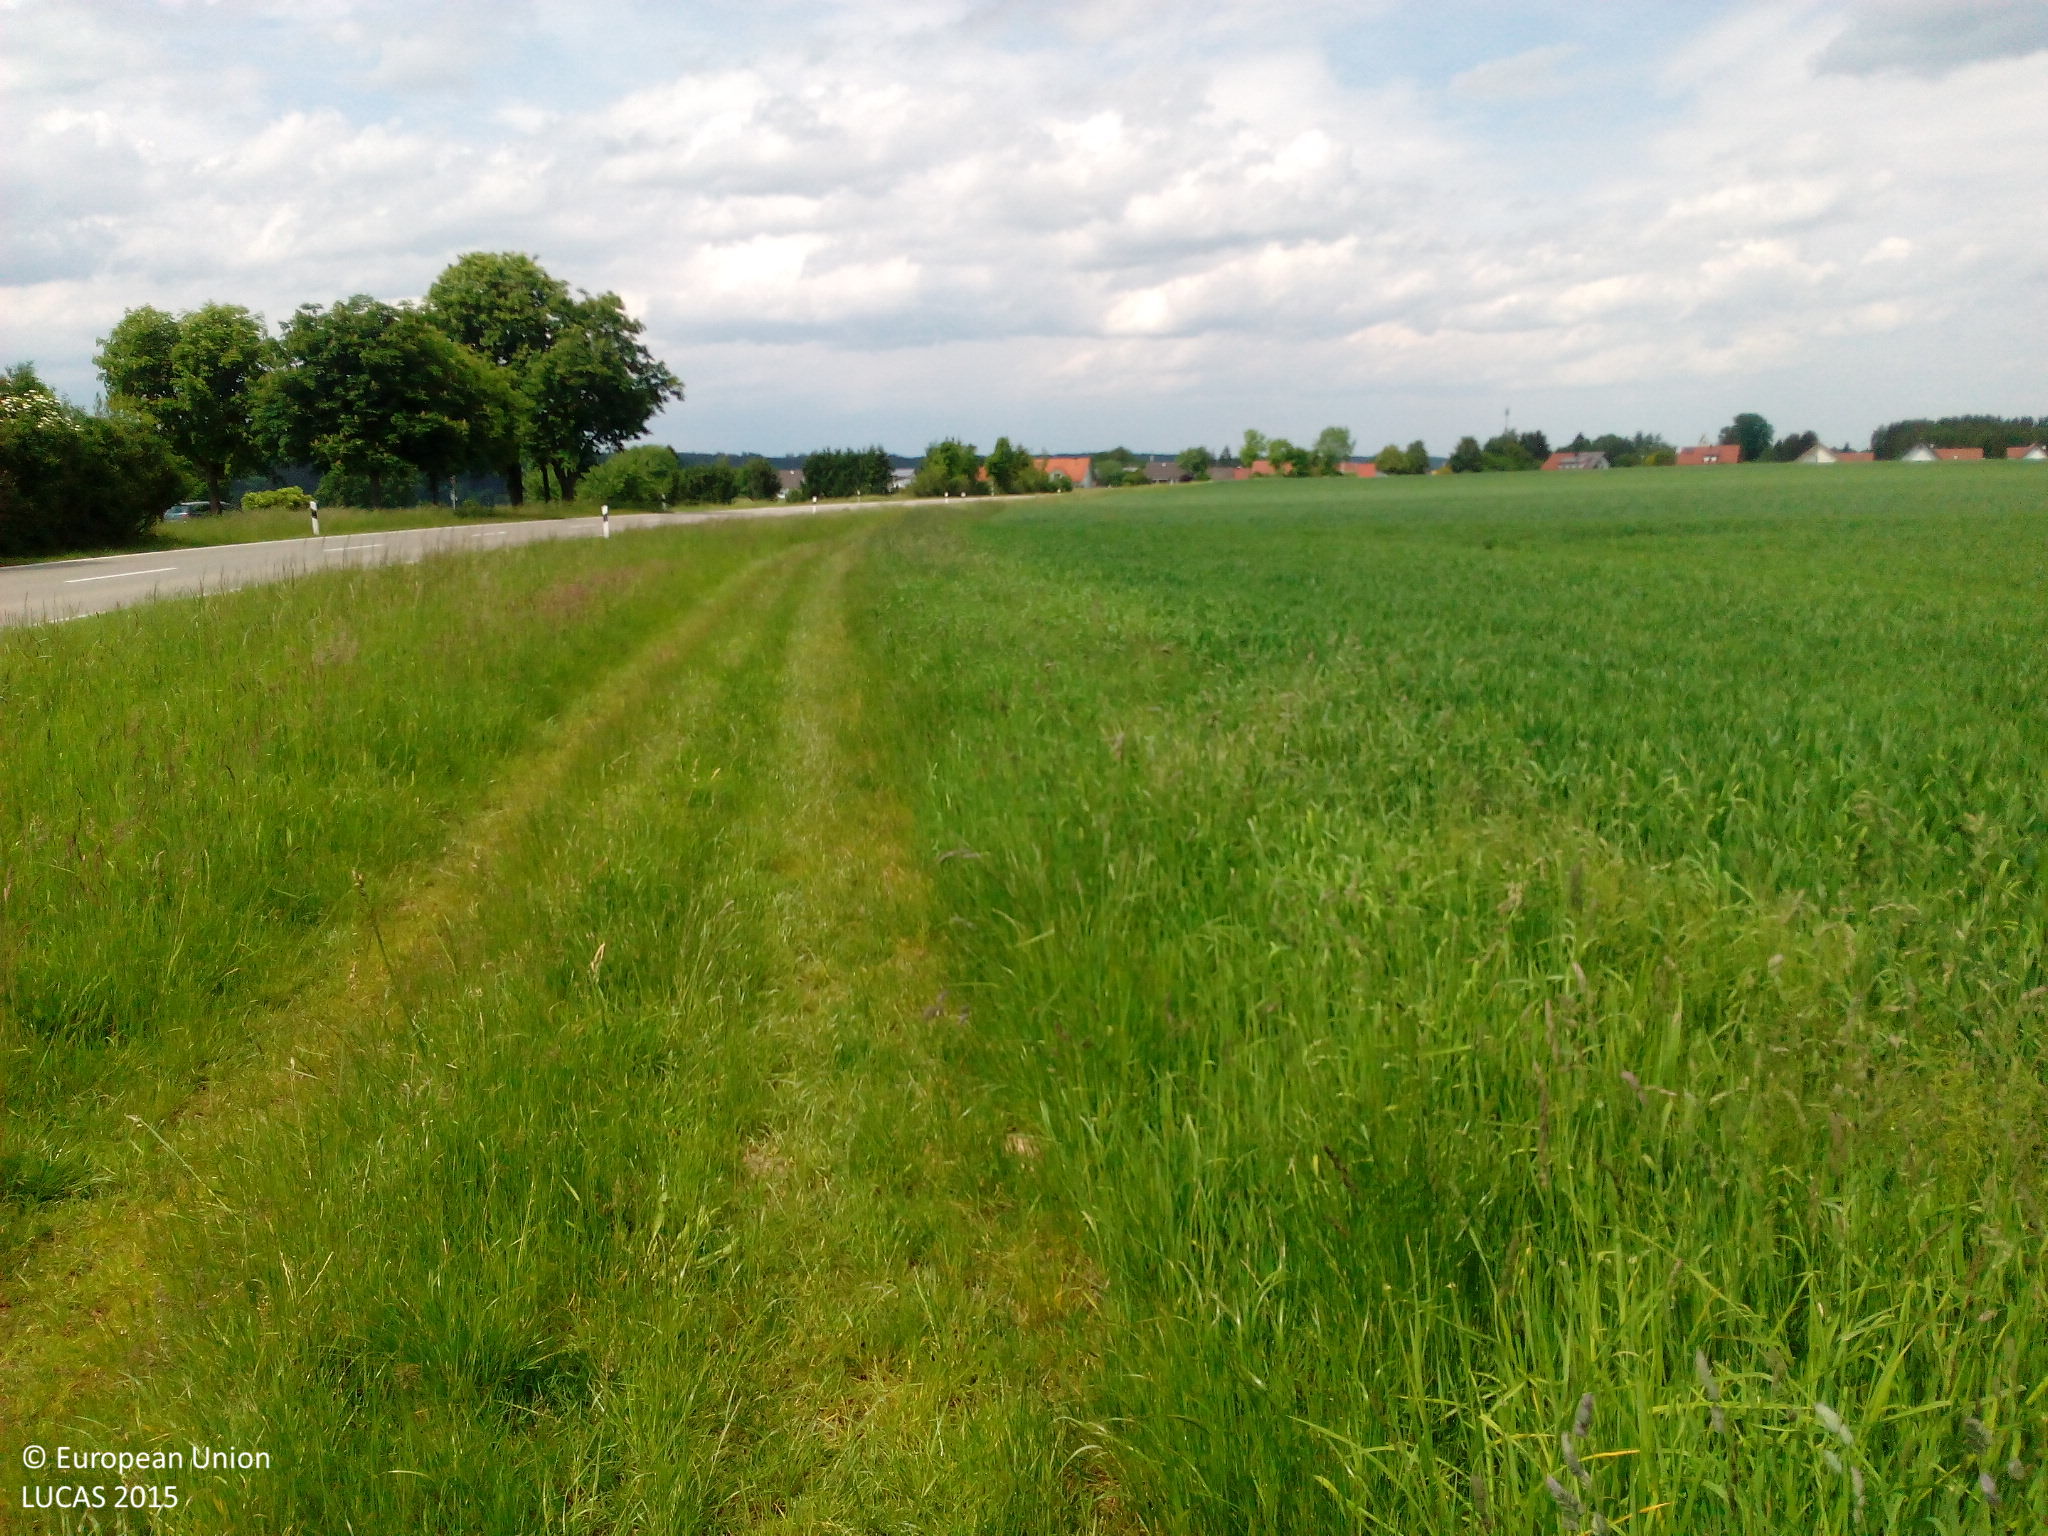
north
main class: Cropland
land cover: Rye
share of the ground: > 75 %
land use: Agriculture (excluding fallow land and kitchen gardens)
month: May
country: DE
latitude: 48.1692
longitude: 10.2553
